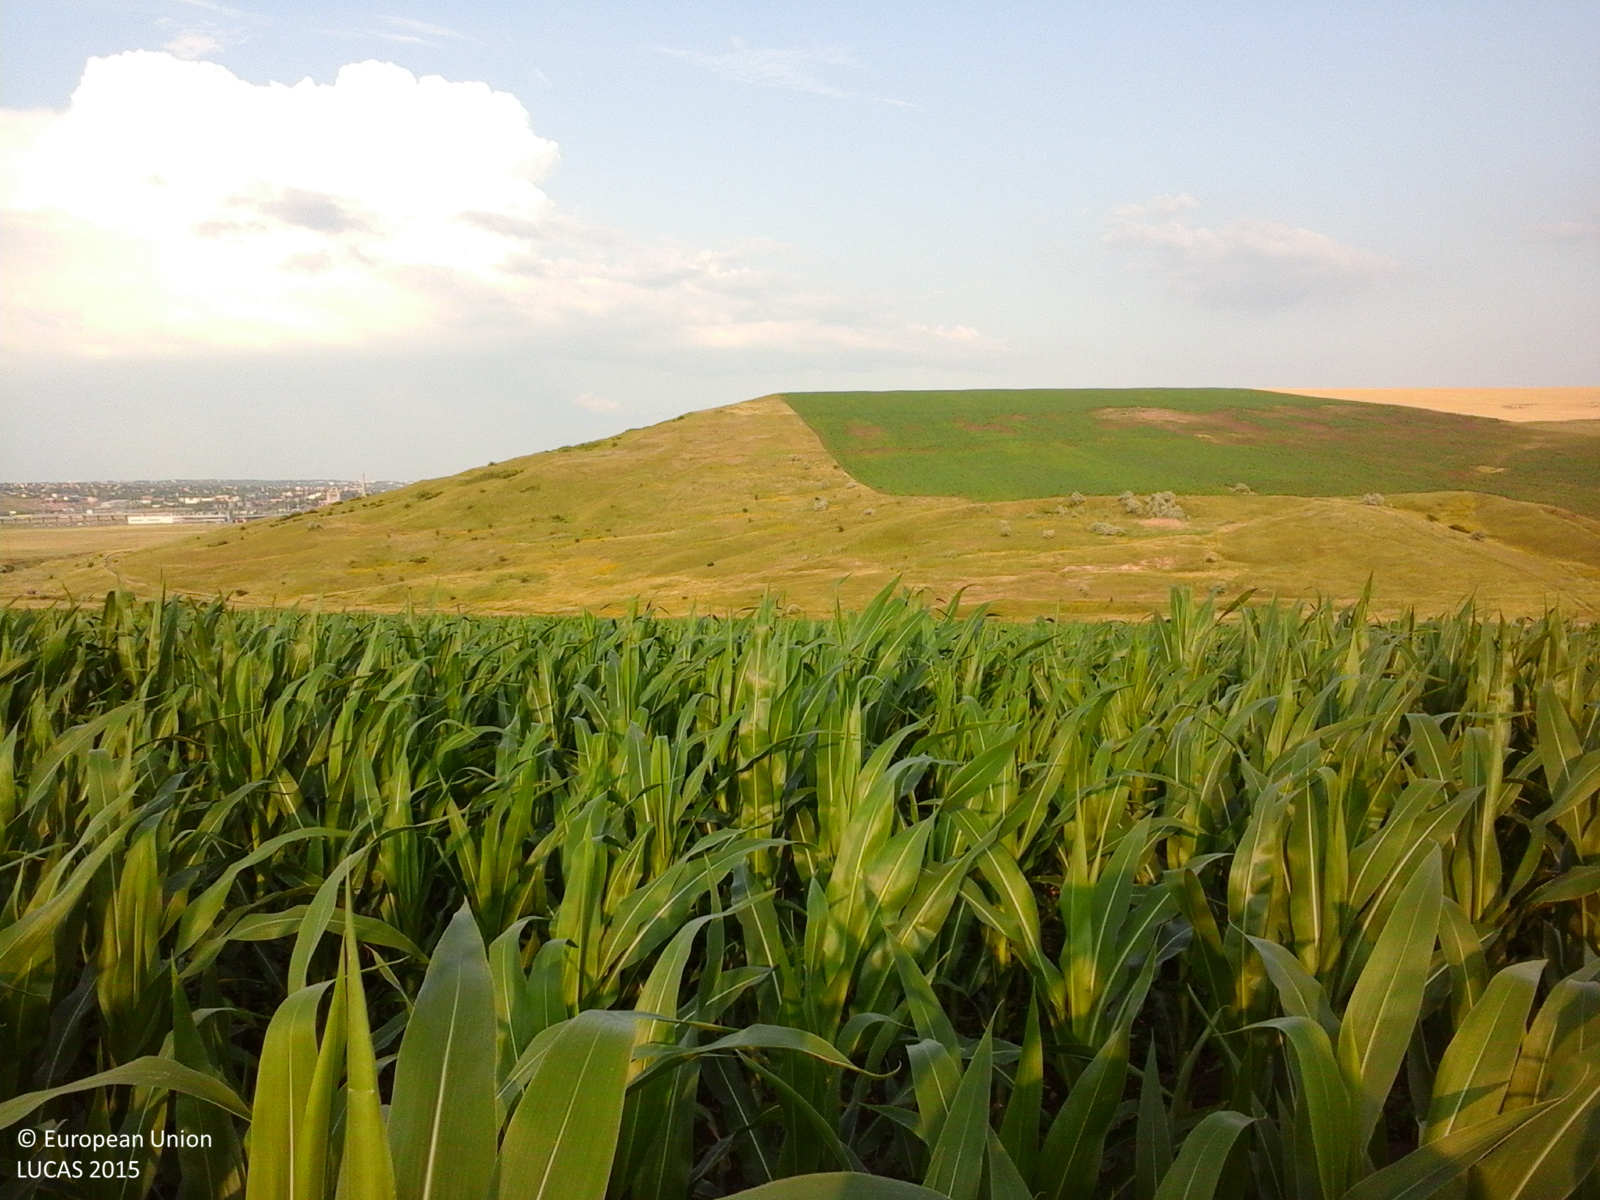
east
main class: Cropland
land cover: Maize
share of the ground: > 75 %
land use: Agriculture (excluding fallow land and kitchen gardens)
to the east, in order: Maize
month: June
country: RO
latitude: 47.1692
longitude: 27.4360
